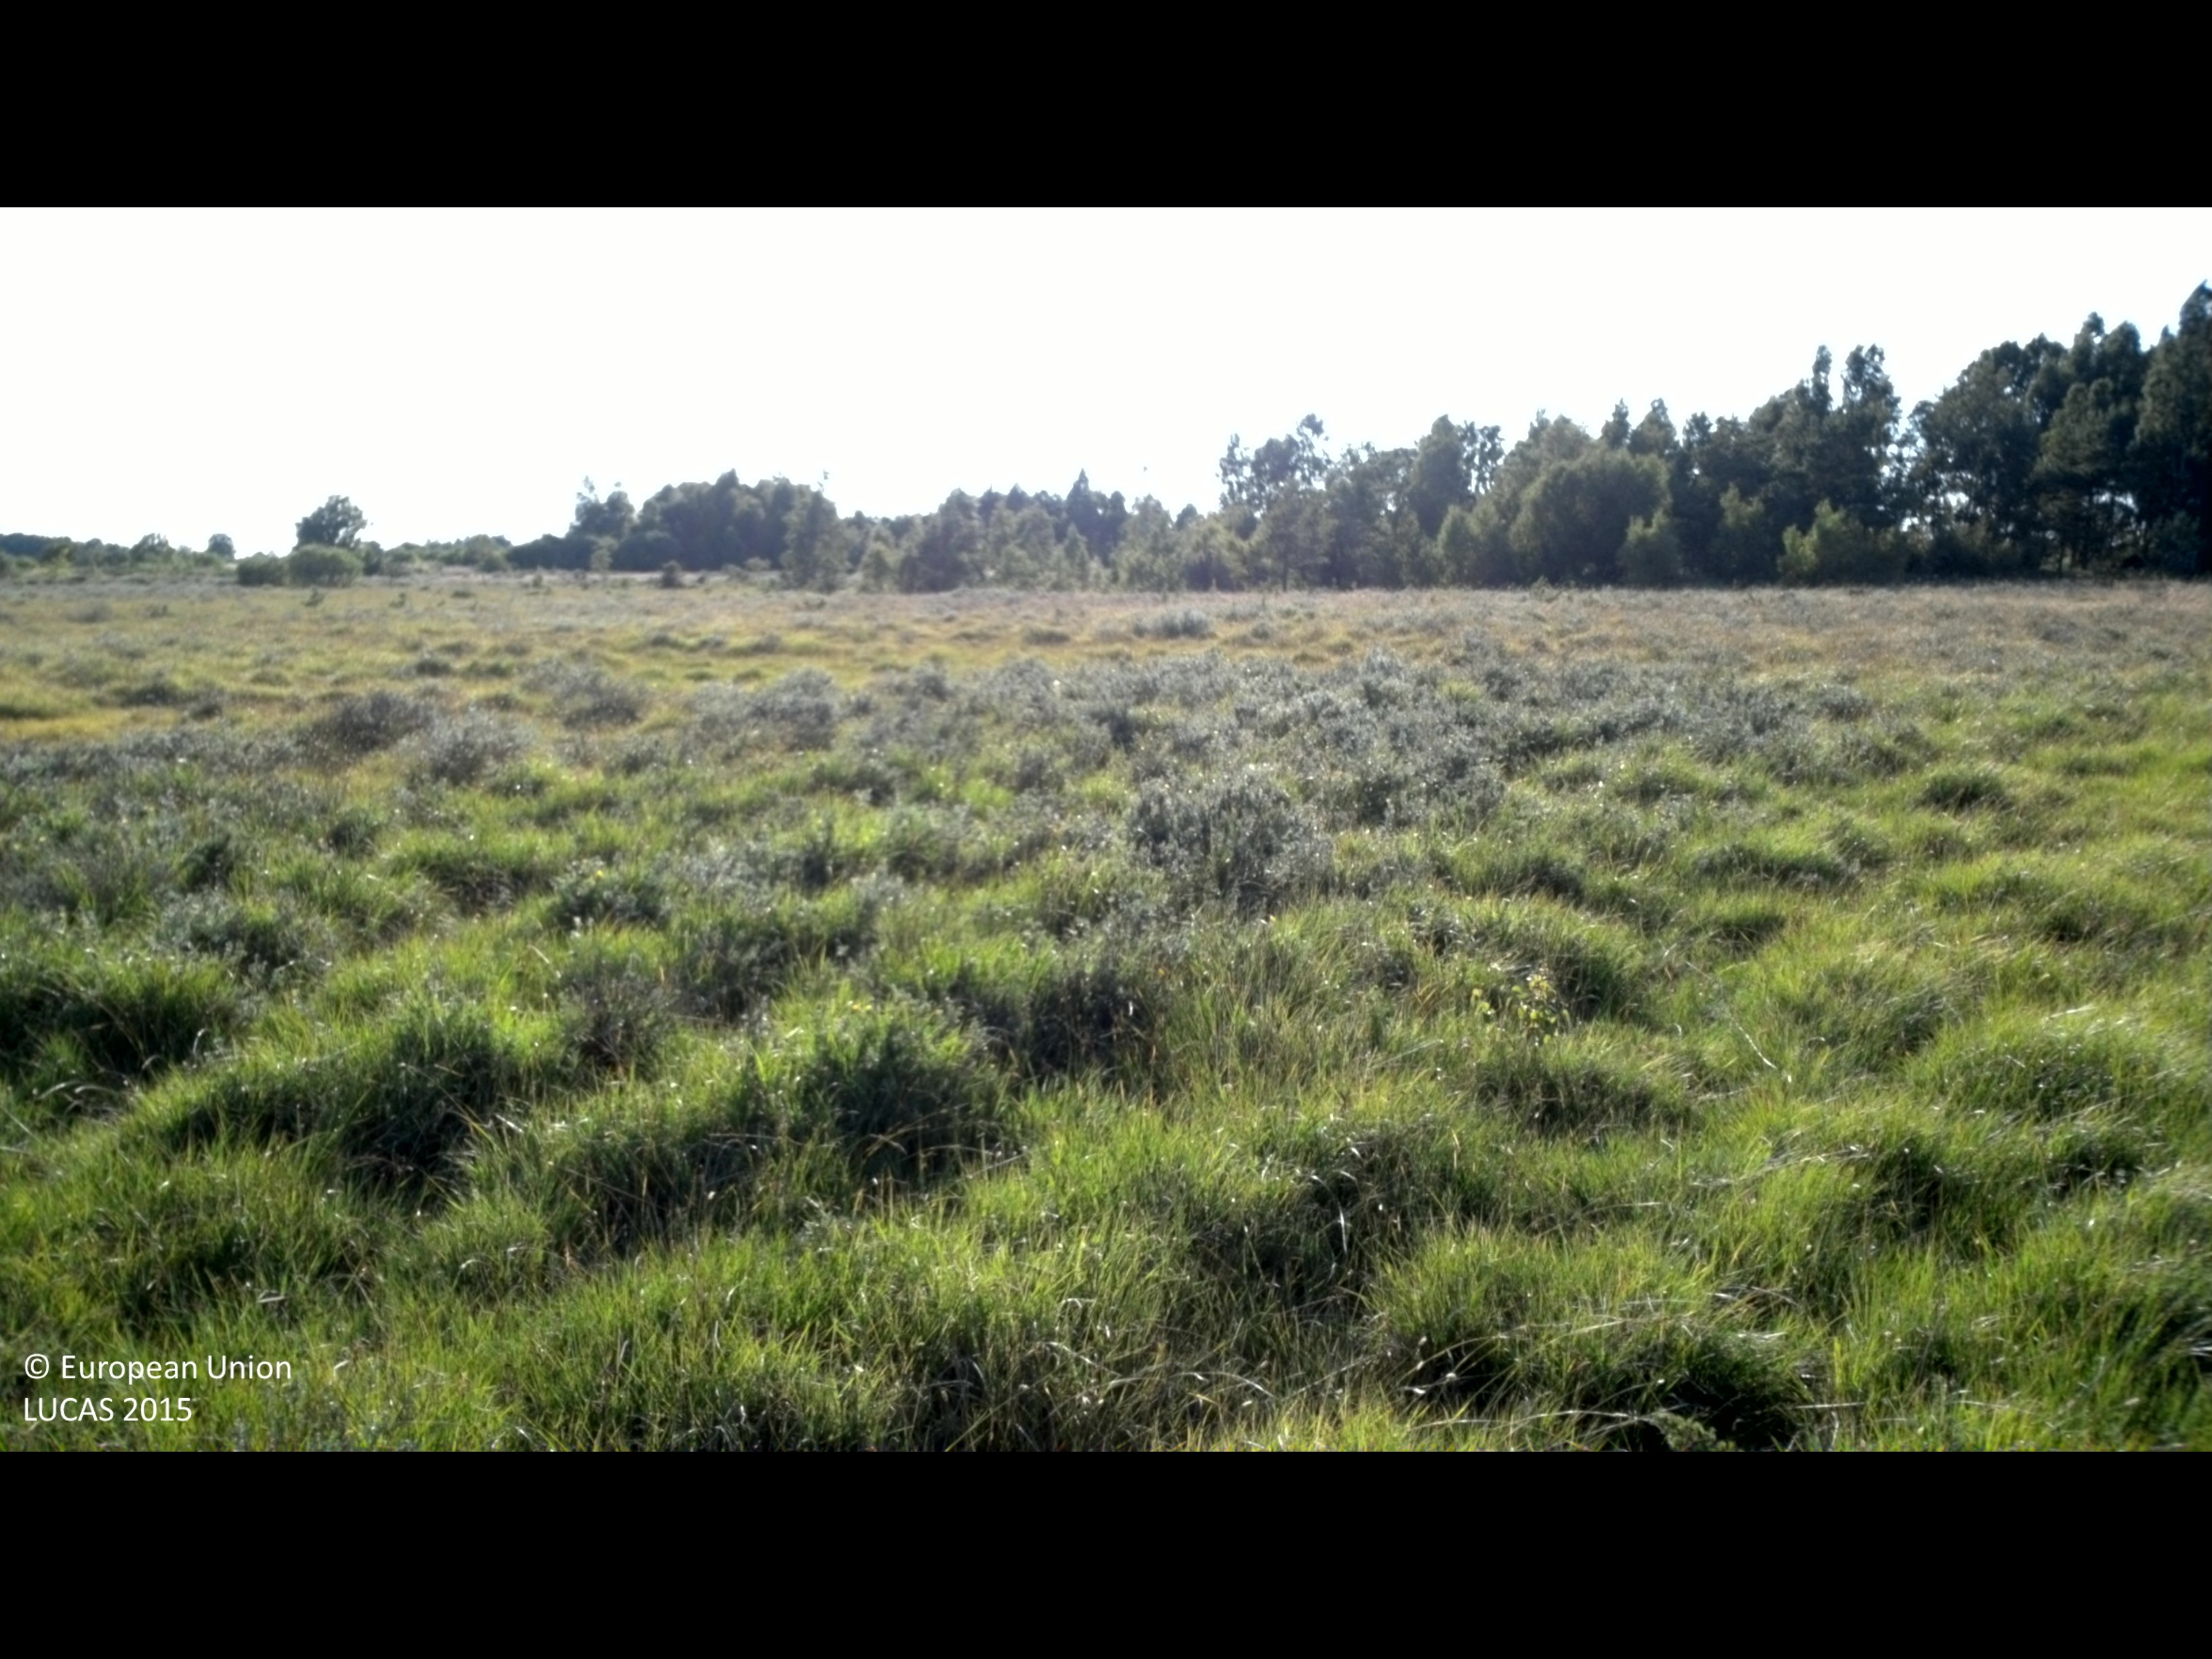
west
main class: Grassland
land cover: Grassland without tree/shrub cover
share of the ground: > 75 %
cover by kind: herbaceous plants 100 %
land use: Agriculture (excluding fallow land and kitchen gardens)
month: July
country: SE
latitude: 56.5239
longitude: 16.5855
